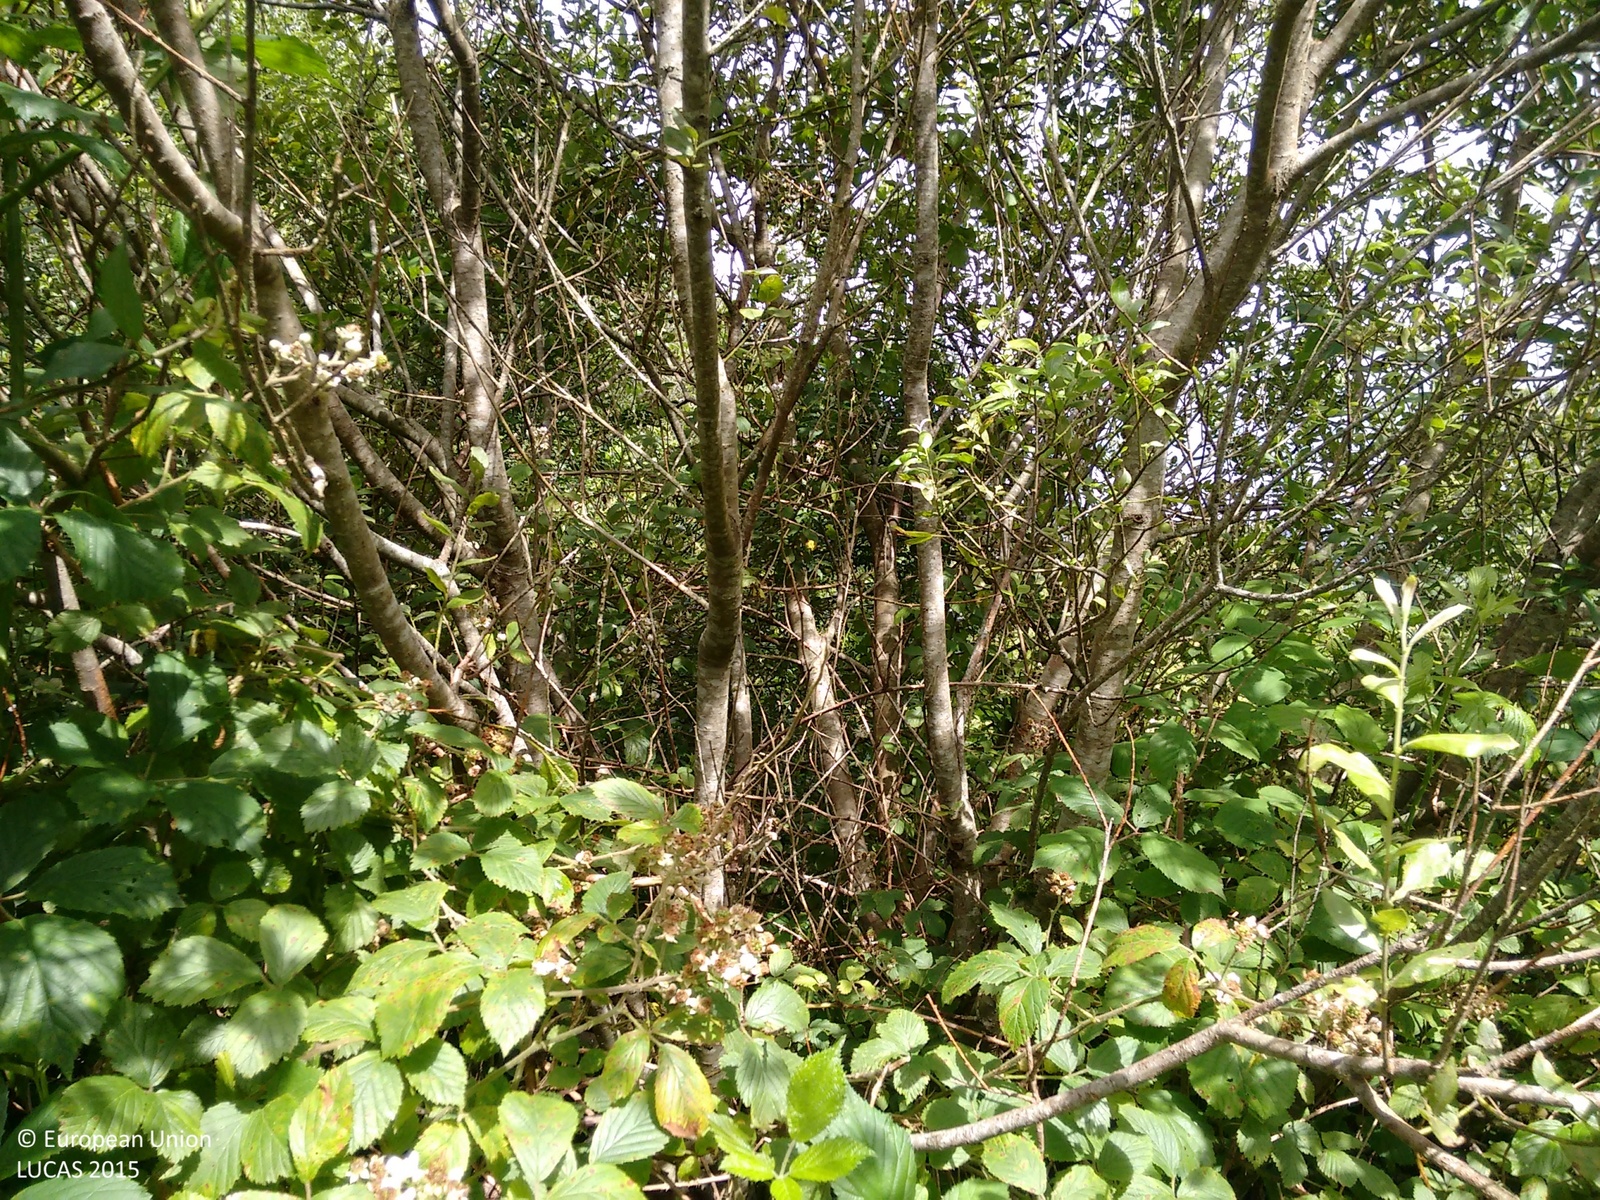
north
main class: Woodland
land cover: Broadleaved woodland
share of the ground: > 75 %
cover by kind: broadleaved forest trees 85 %, shrubs 15 %
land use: Abandoned areas
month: August
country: IE
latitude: 51.7376
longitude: -9.3867
